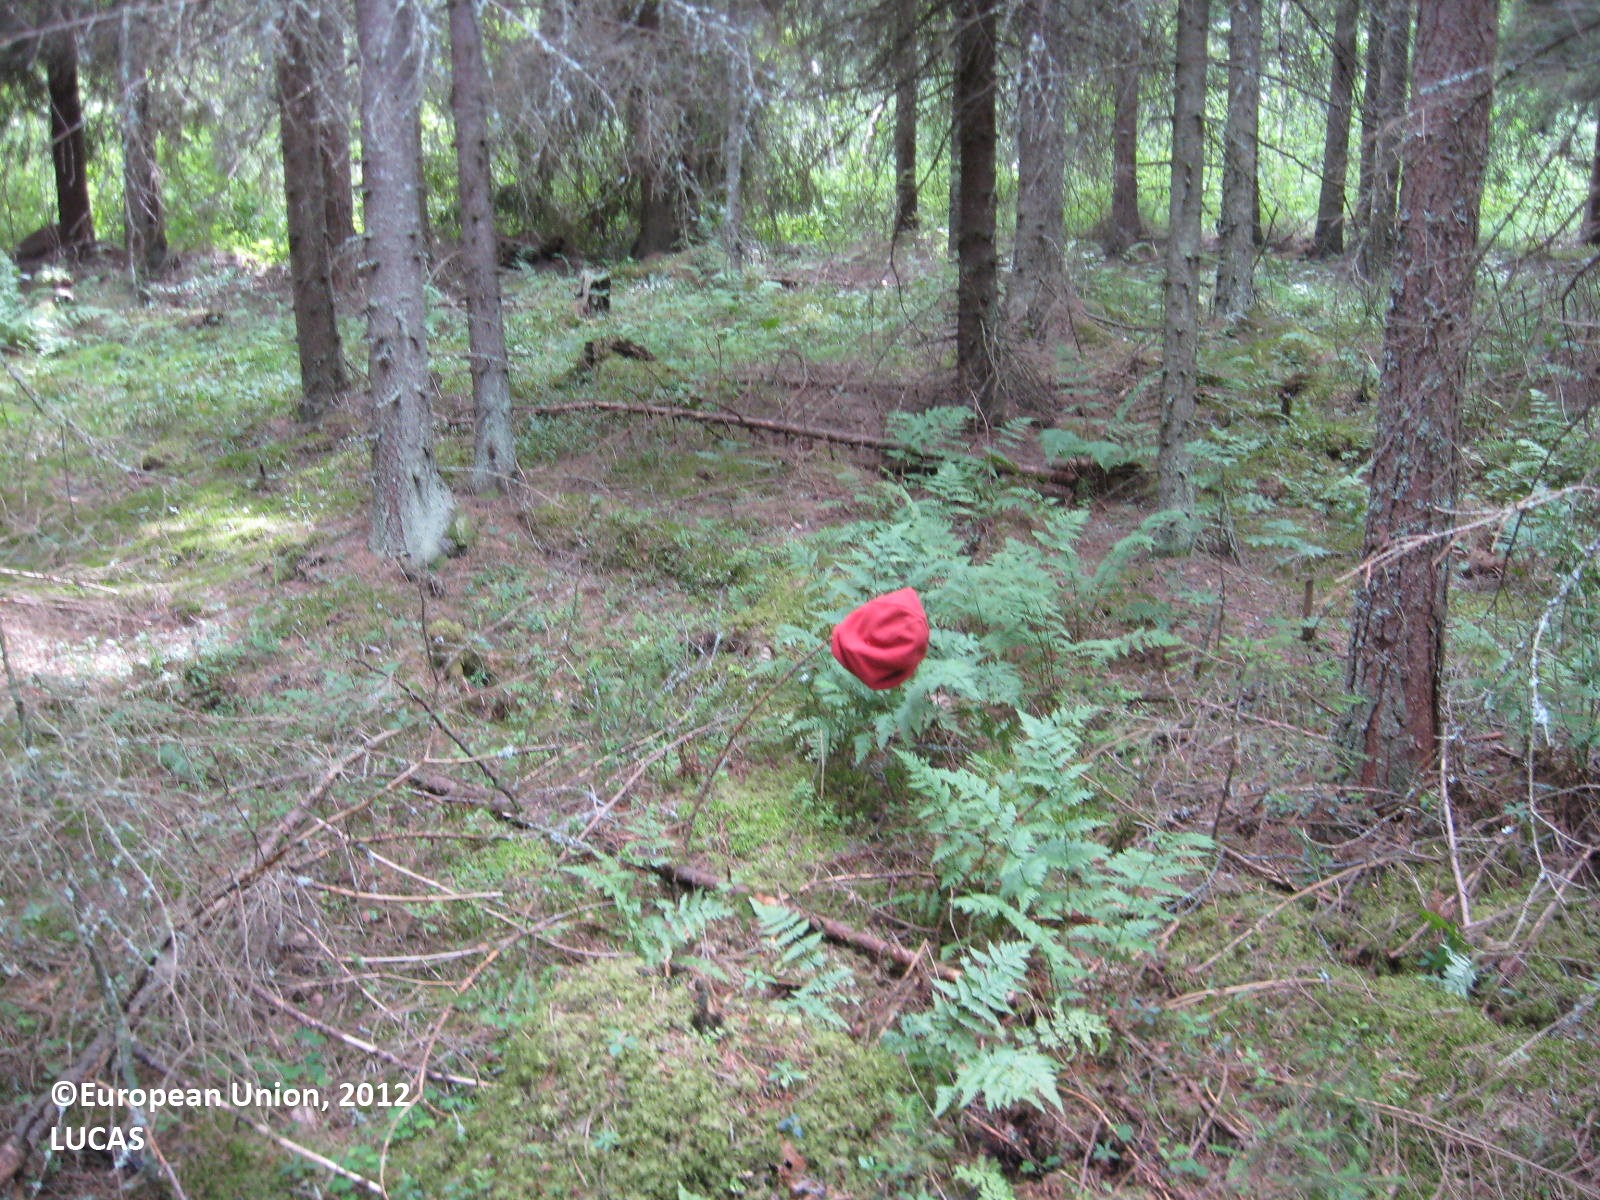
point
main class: Woodland
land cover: Spruce dominated coniferous woodland
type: boreal forest
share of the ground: > 75 %
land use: Forestry
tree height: > 5 m
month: July
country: FI
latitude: 62.4297
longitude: 21.4505
